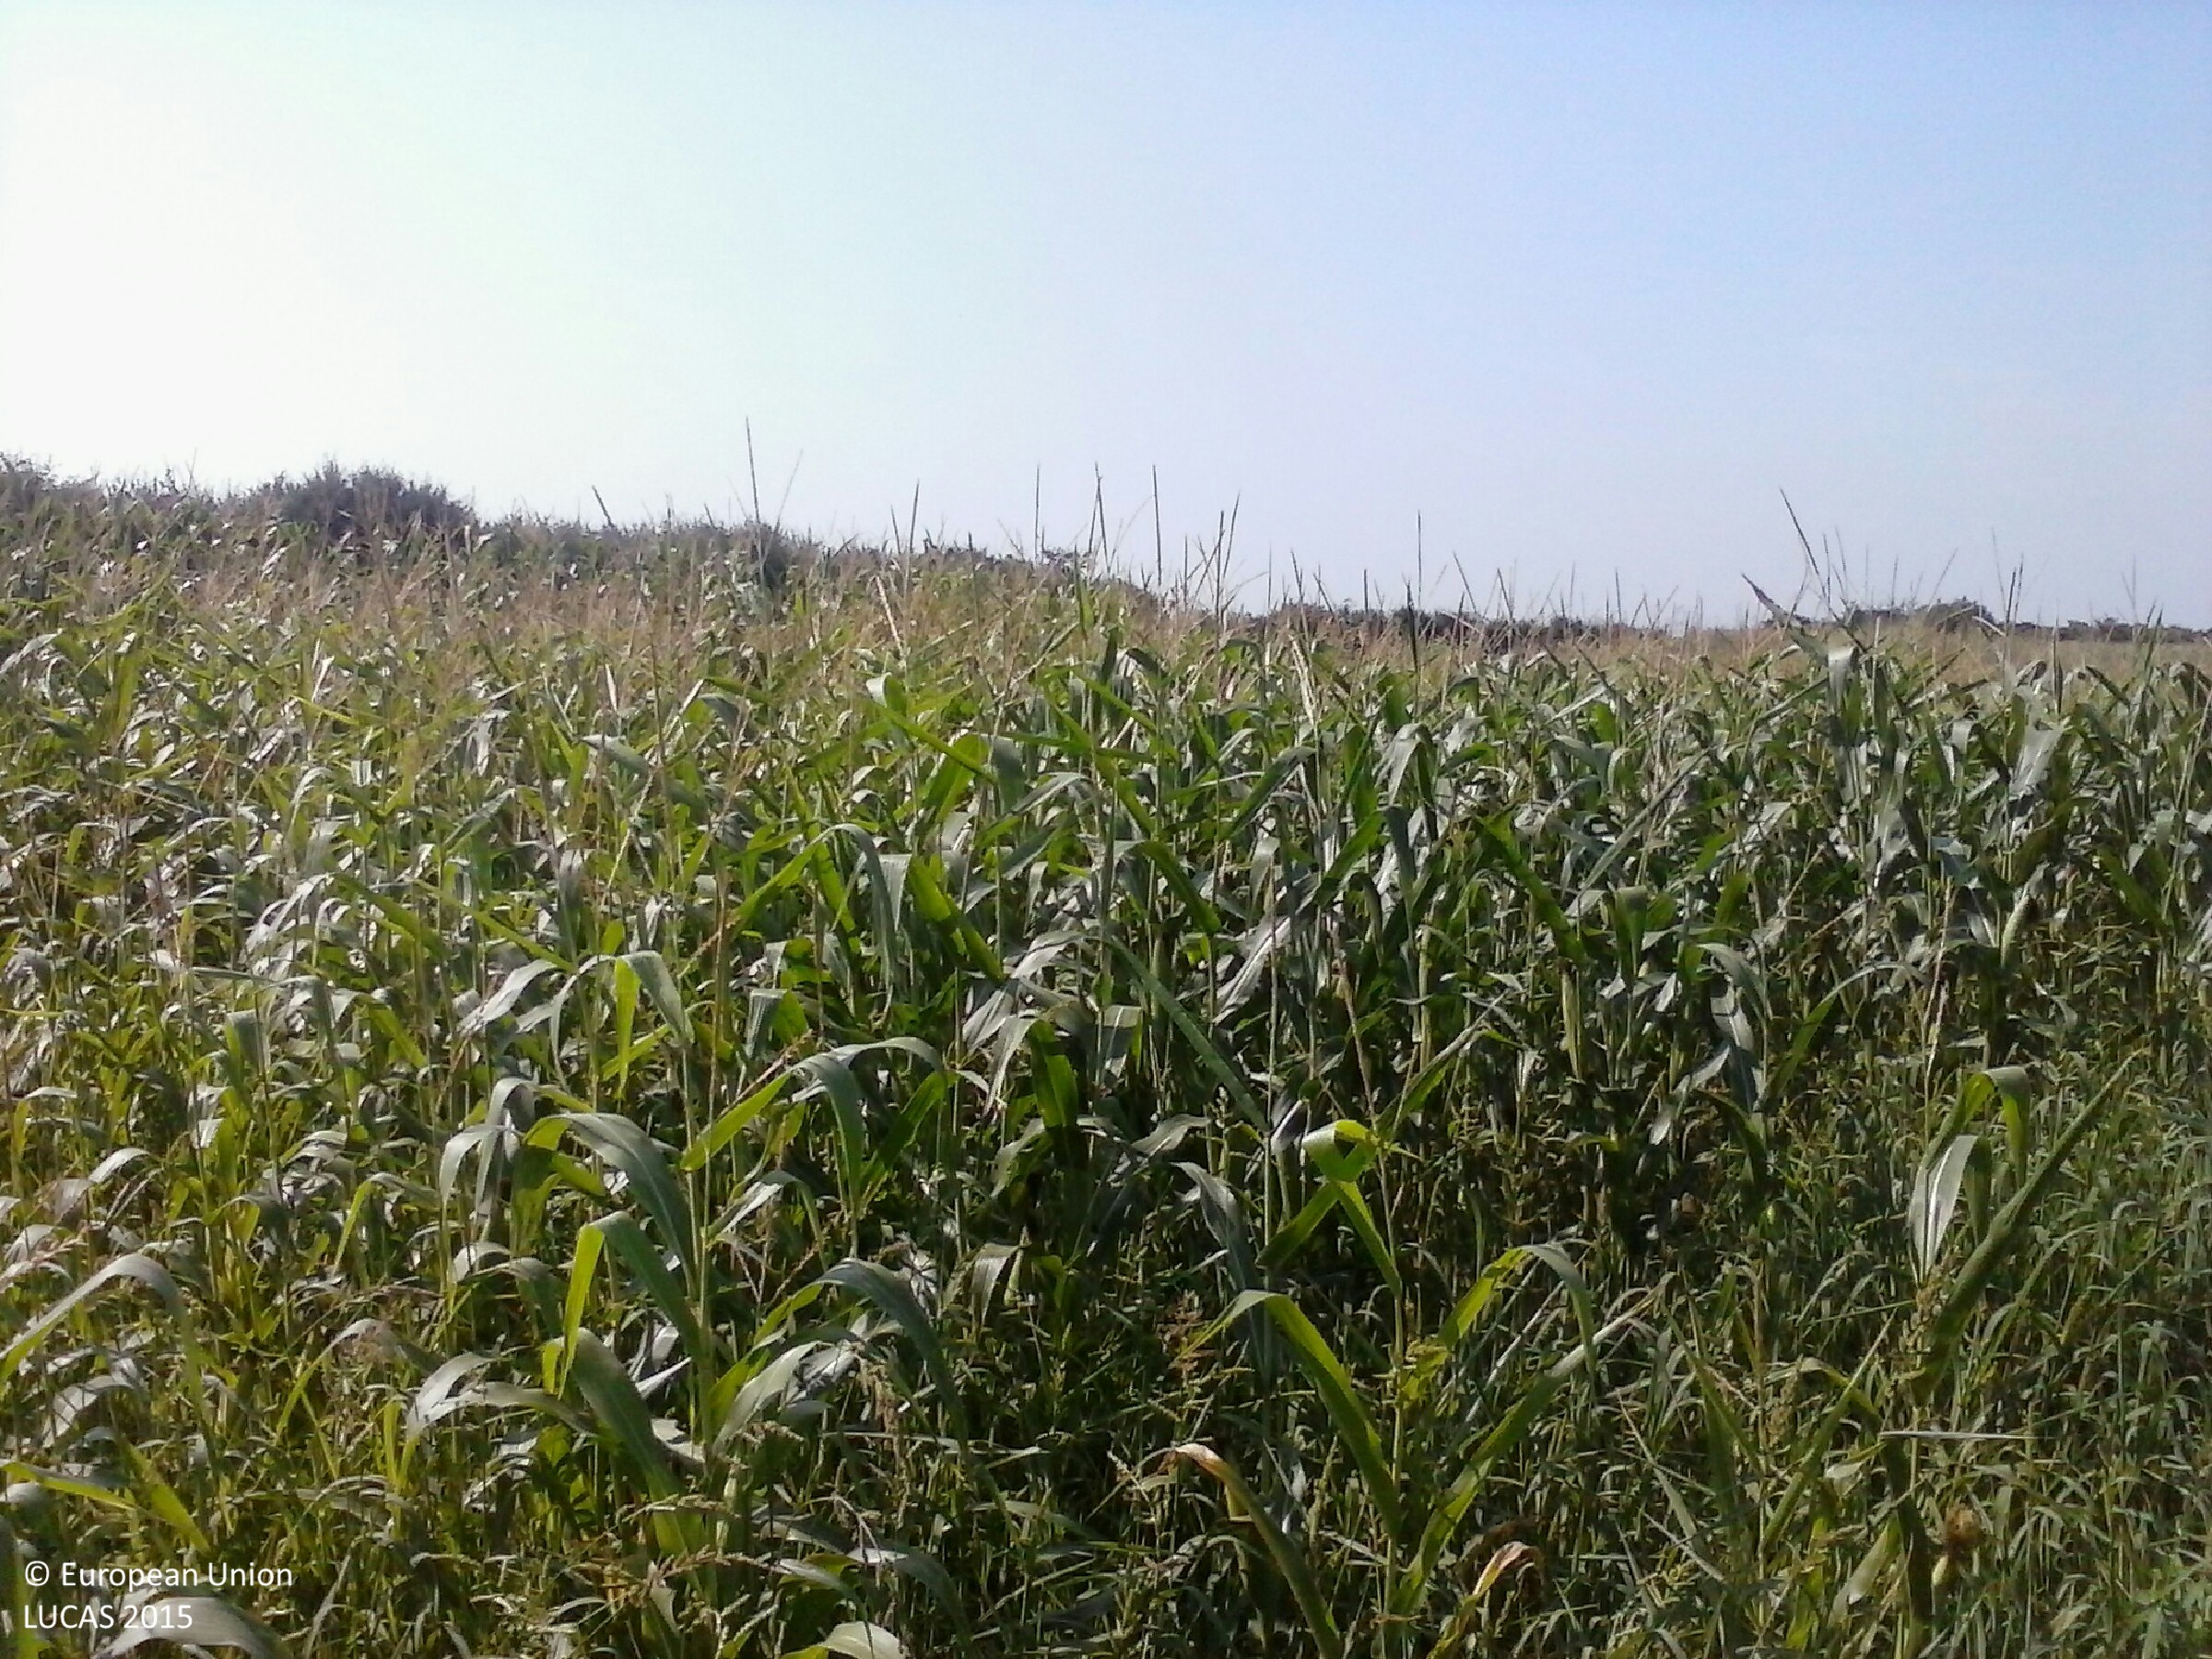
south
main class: Cropland
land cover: Maize
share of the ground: 25 - 50 %
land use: Agriculture (excluding fallow land and kitchen gardens)
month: August
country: HU
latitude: 45.9850
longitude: 17.9184
